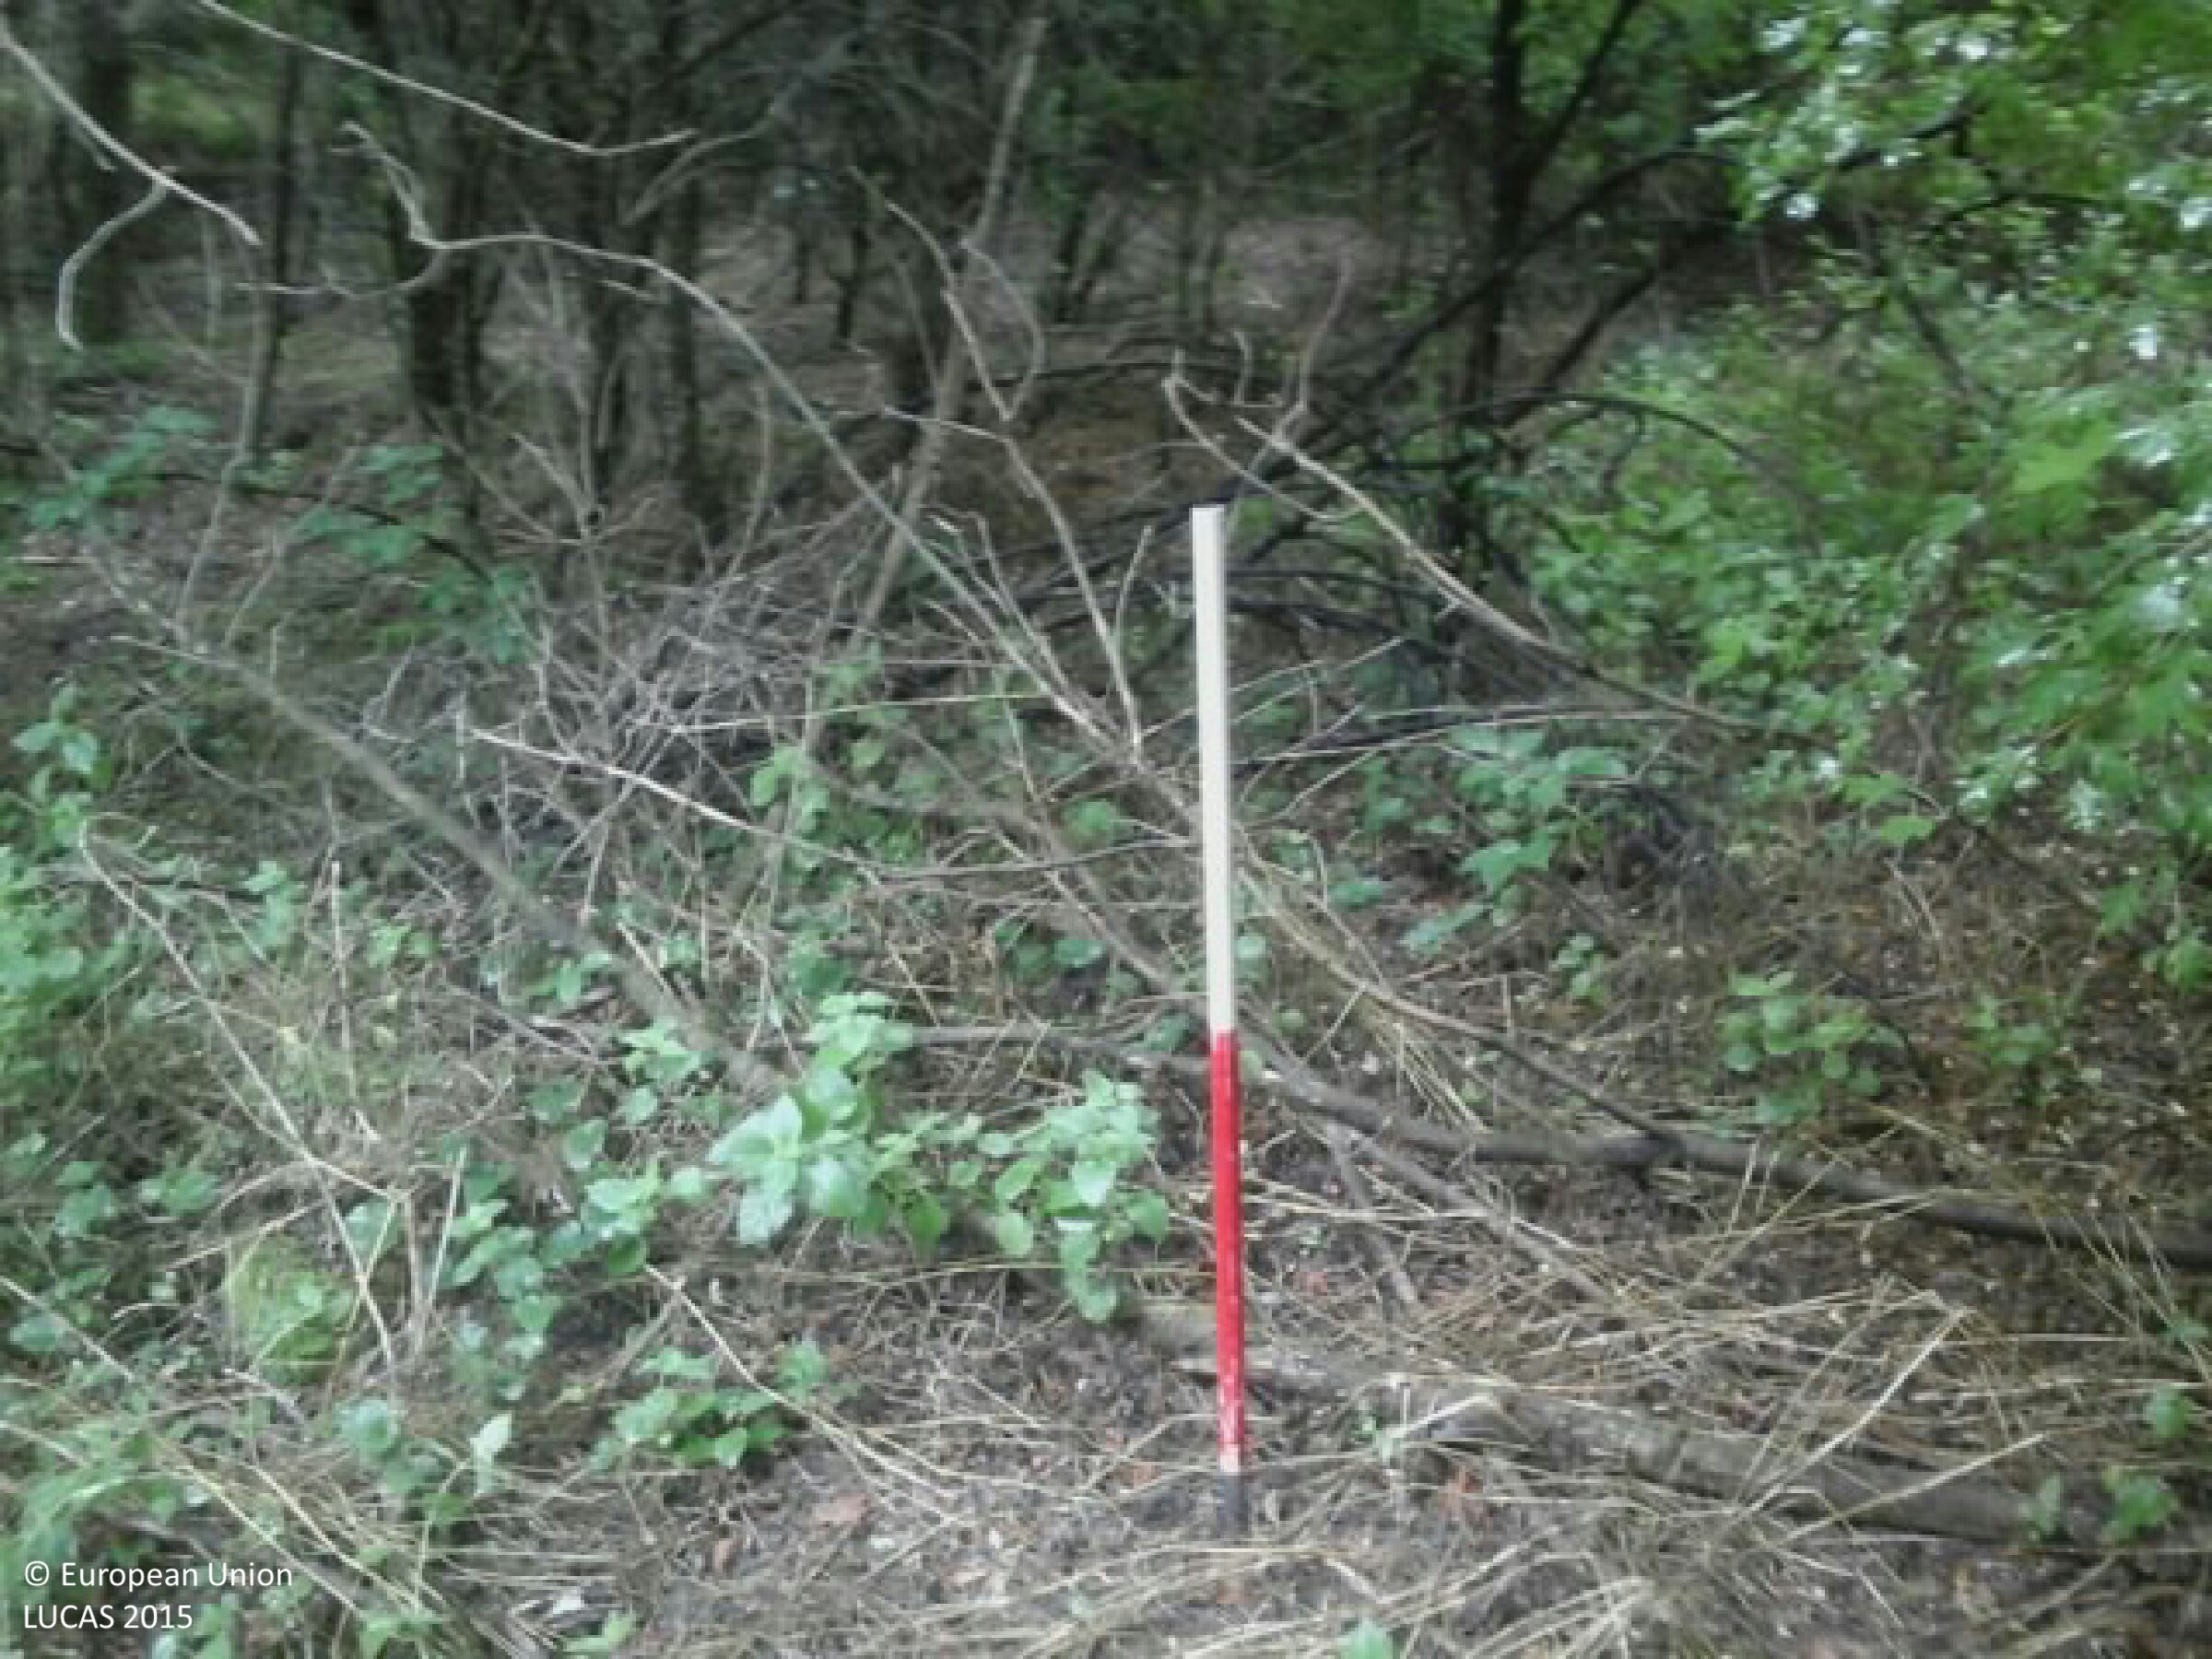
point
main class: Woodland
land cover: Broadleaved woodland
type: mesophytic deciduous forest
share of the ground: > 75 %
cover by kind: broadleaved forest trees 80 %, herbaceous plants 20 %
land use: Forestry
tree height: > 5 m
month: June
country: HU
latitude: 46.2429
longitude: 19.0003
